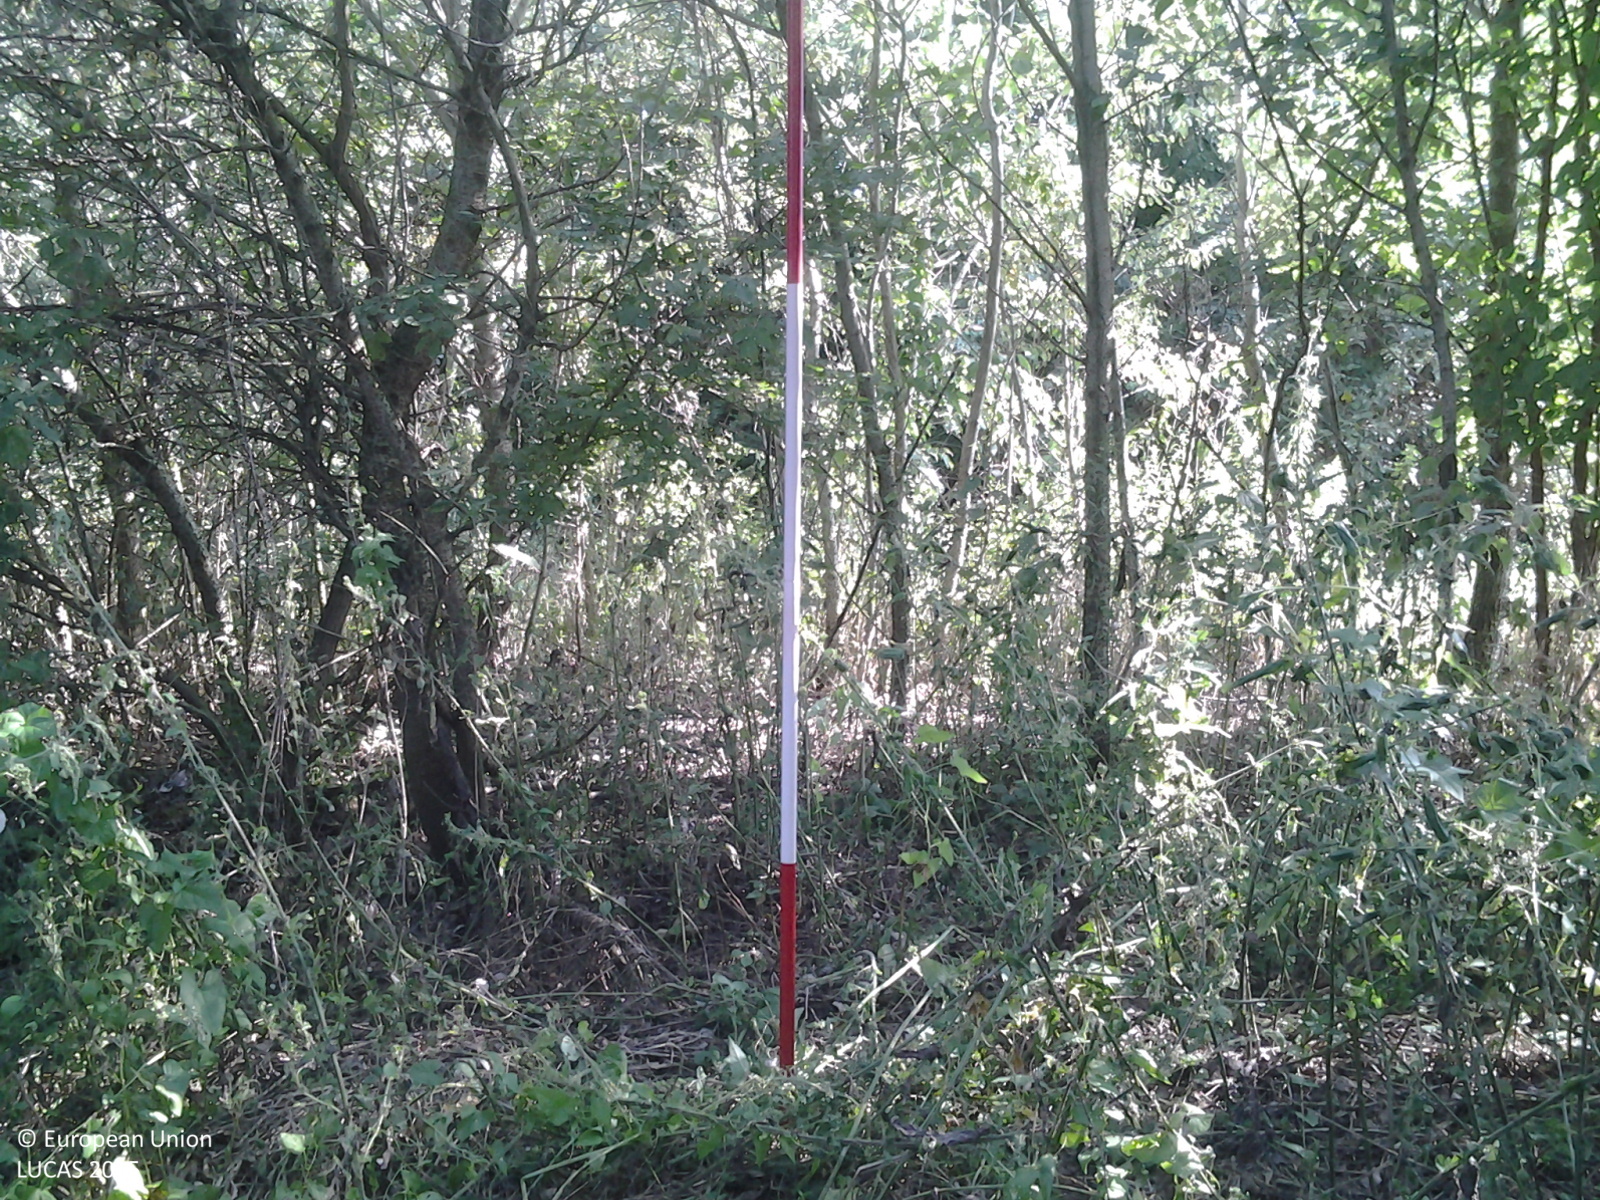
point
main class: Woodland
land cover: Broadleaved woodland
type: floodplain forest
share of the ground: > 75 %
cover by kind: broadleaved forest trees 95 %, herbaceous plants 5 %
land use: Forestry
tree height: > 5 m
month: August
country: HU
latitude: 46.4386
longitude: 18.1427
